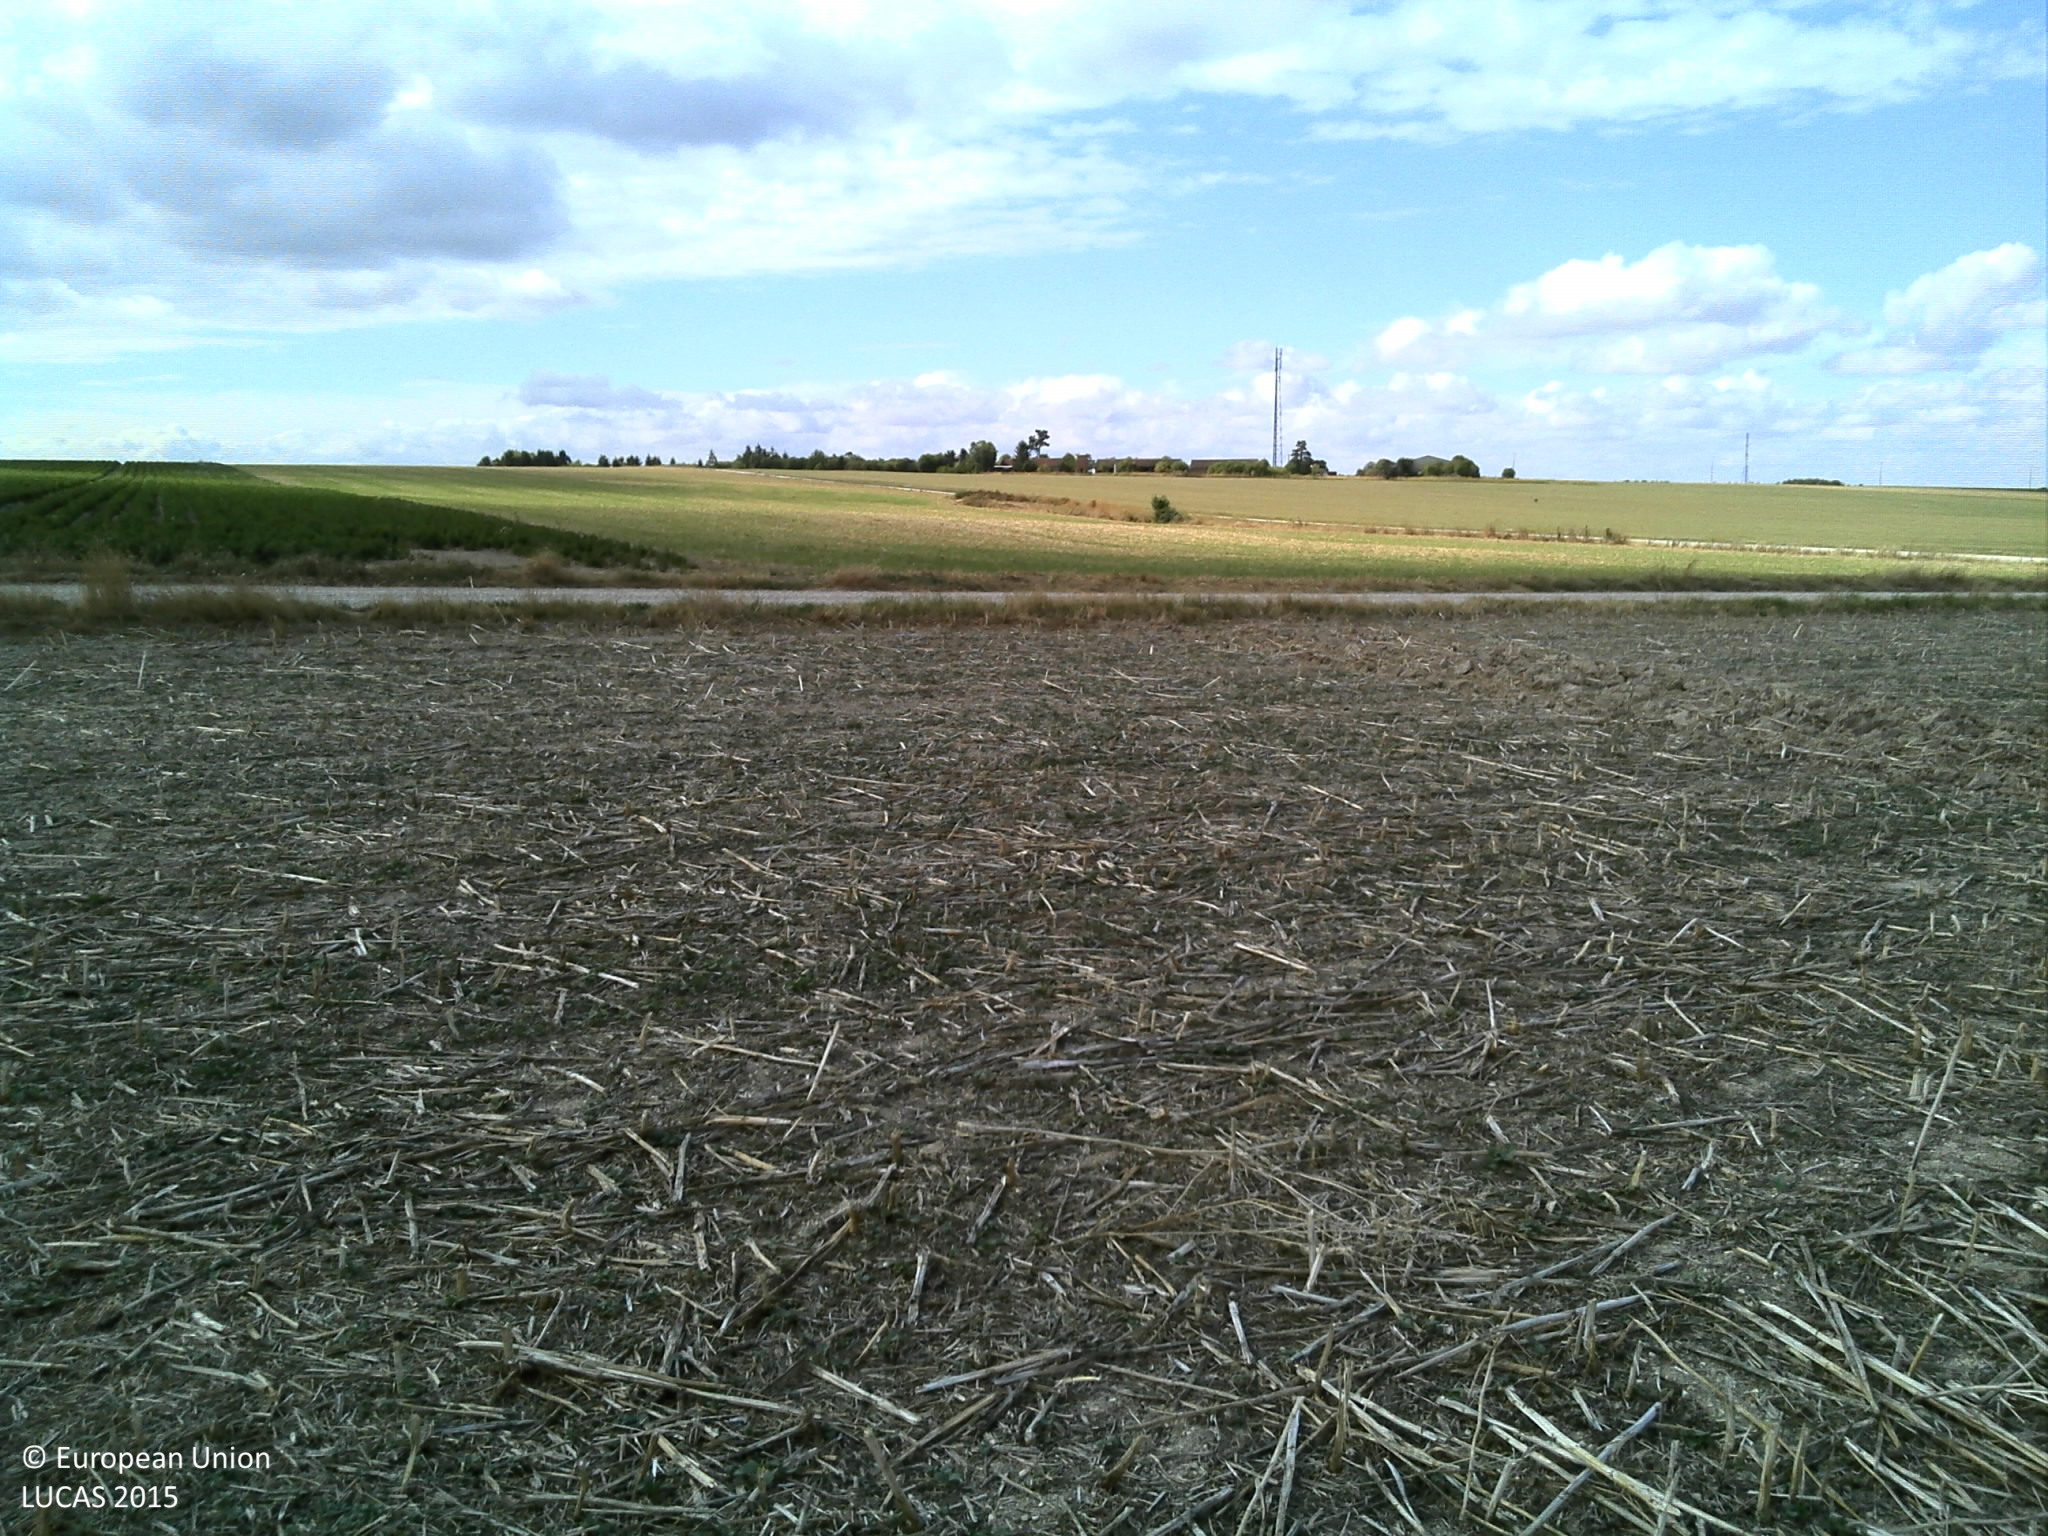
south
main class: Cropland
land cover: Rape and turnip rape
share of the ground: > 75 %
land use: Agriculture (excluding fallow land and kitchen gardens)
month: August
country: FR
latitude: 48.7406
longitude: 4.2441
